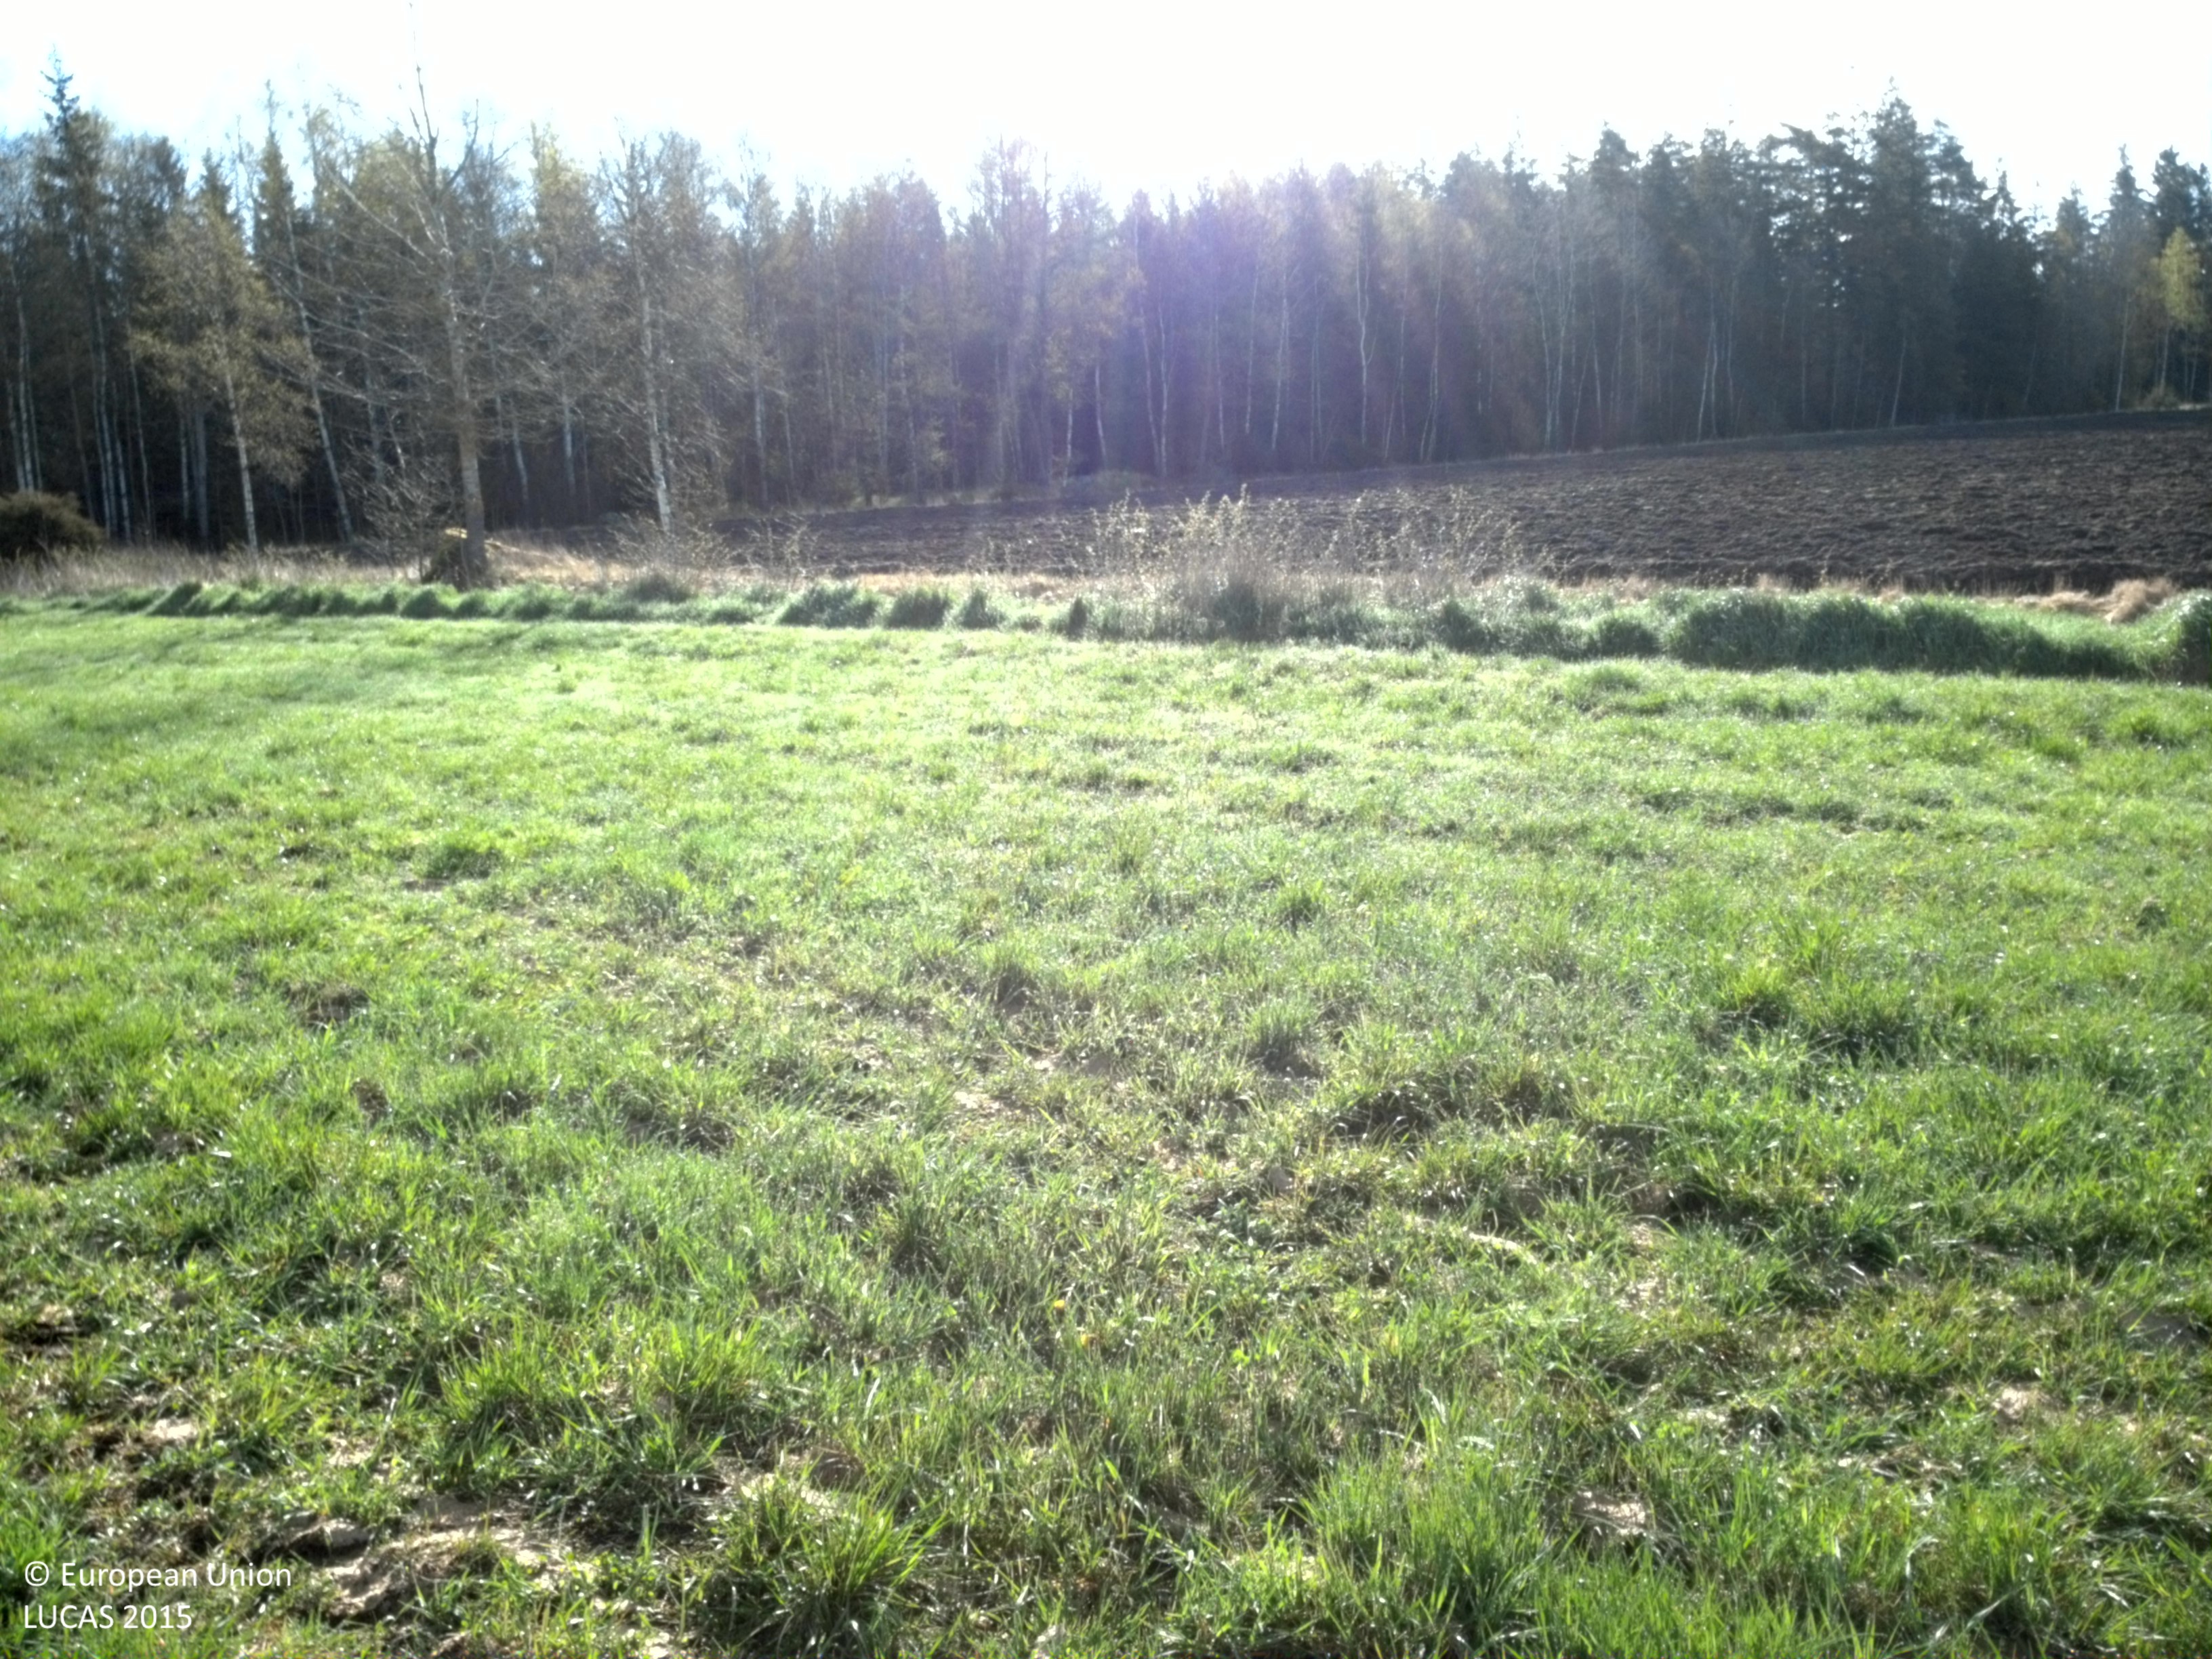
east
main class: Grassland
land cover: Grassland without tree/shrub cover
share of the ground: > 75 %
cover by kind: herbaceous plants 100 %
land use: Agriculture (excluding fallow land and kitchen gardens)
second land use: Amenities, museums, leisure
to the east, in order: Grassland without tree/shrub cover; Grass margins; Ditches and canals; Grass margins; Other bare soil; Grass margins; Ditches and canals; Broadleaved woodland; Spruce dominated coniferous woodland; Ditches and canals; Tracks; Spruce dominated coniferous woodland
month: May
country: SE
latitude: 56.7624
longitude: 14.8559
